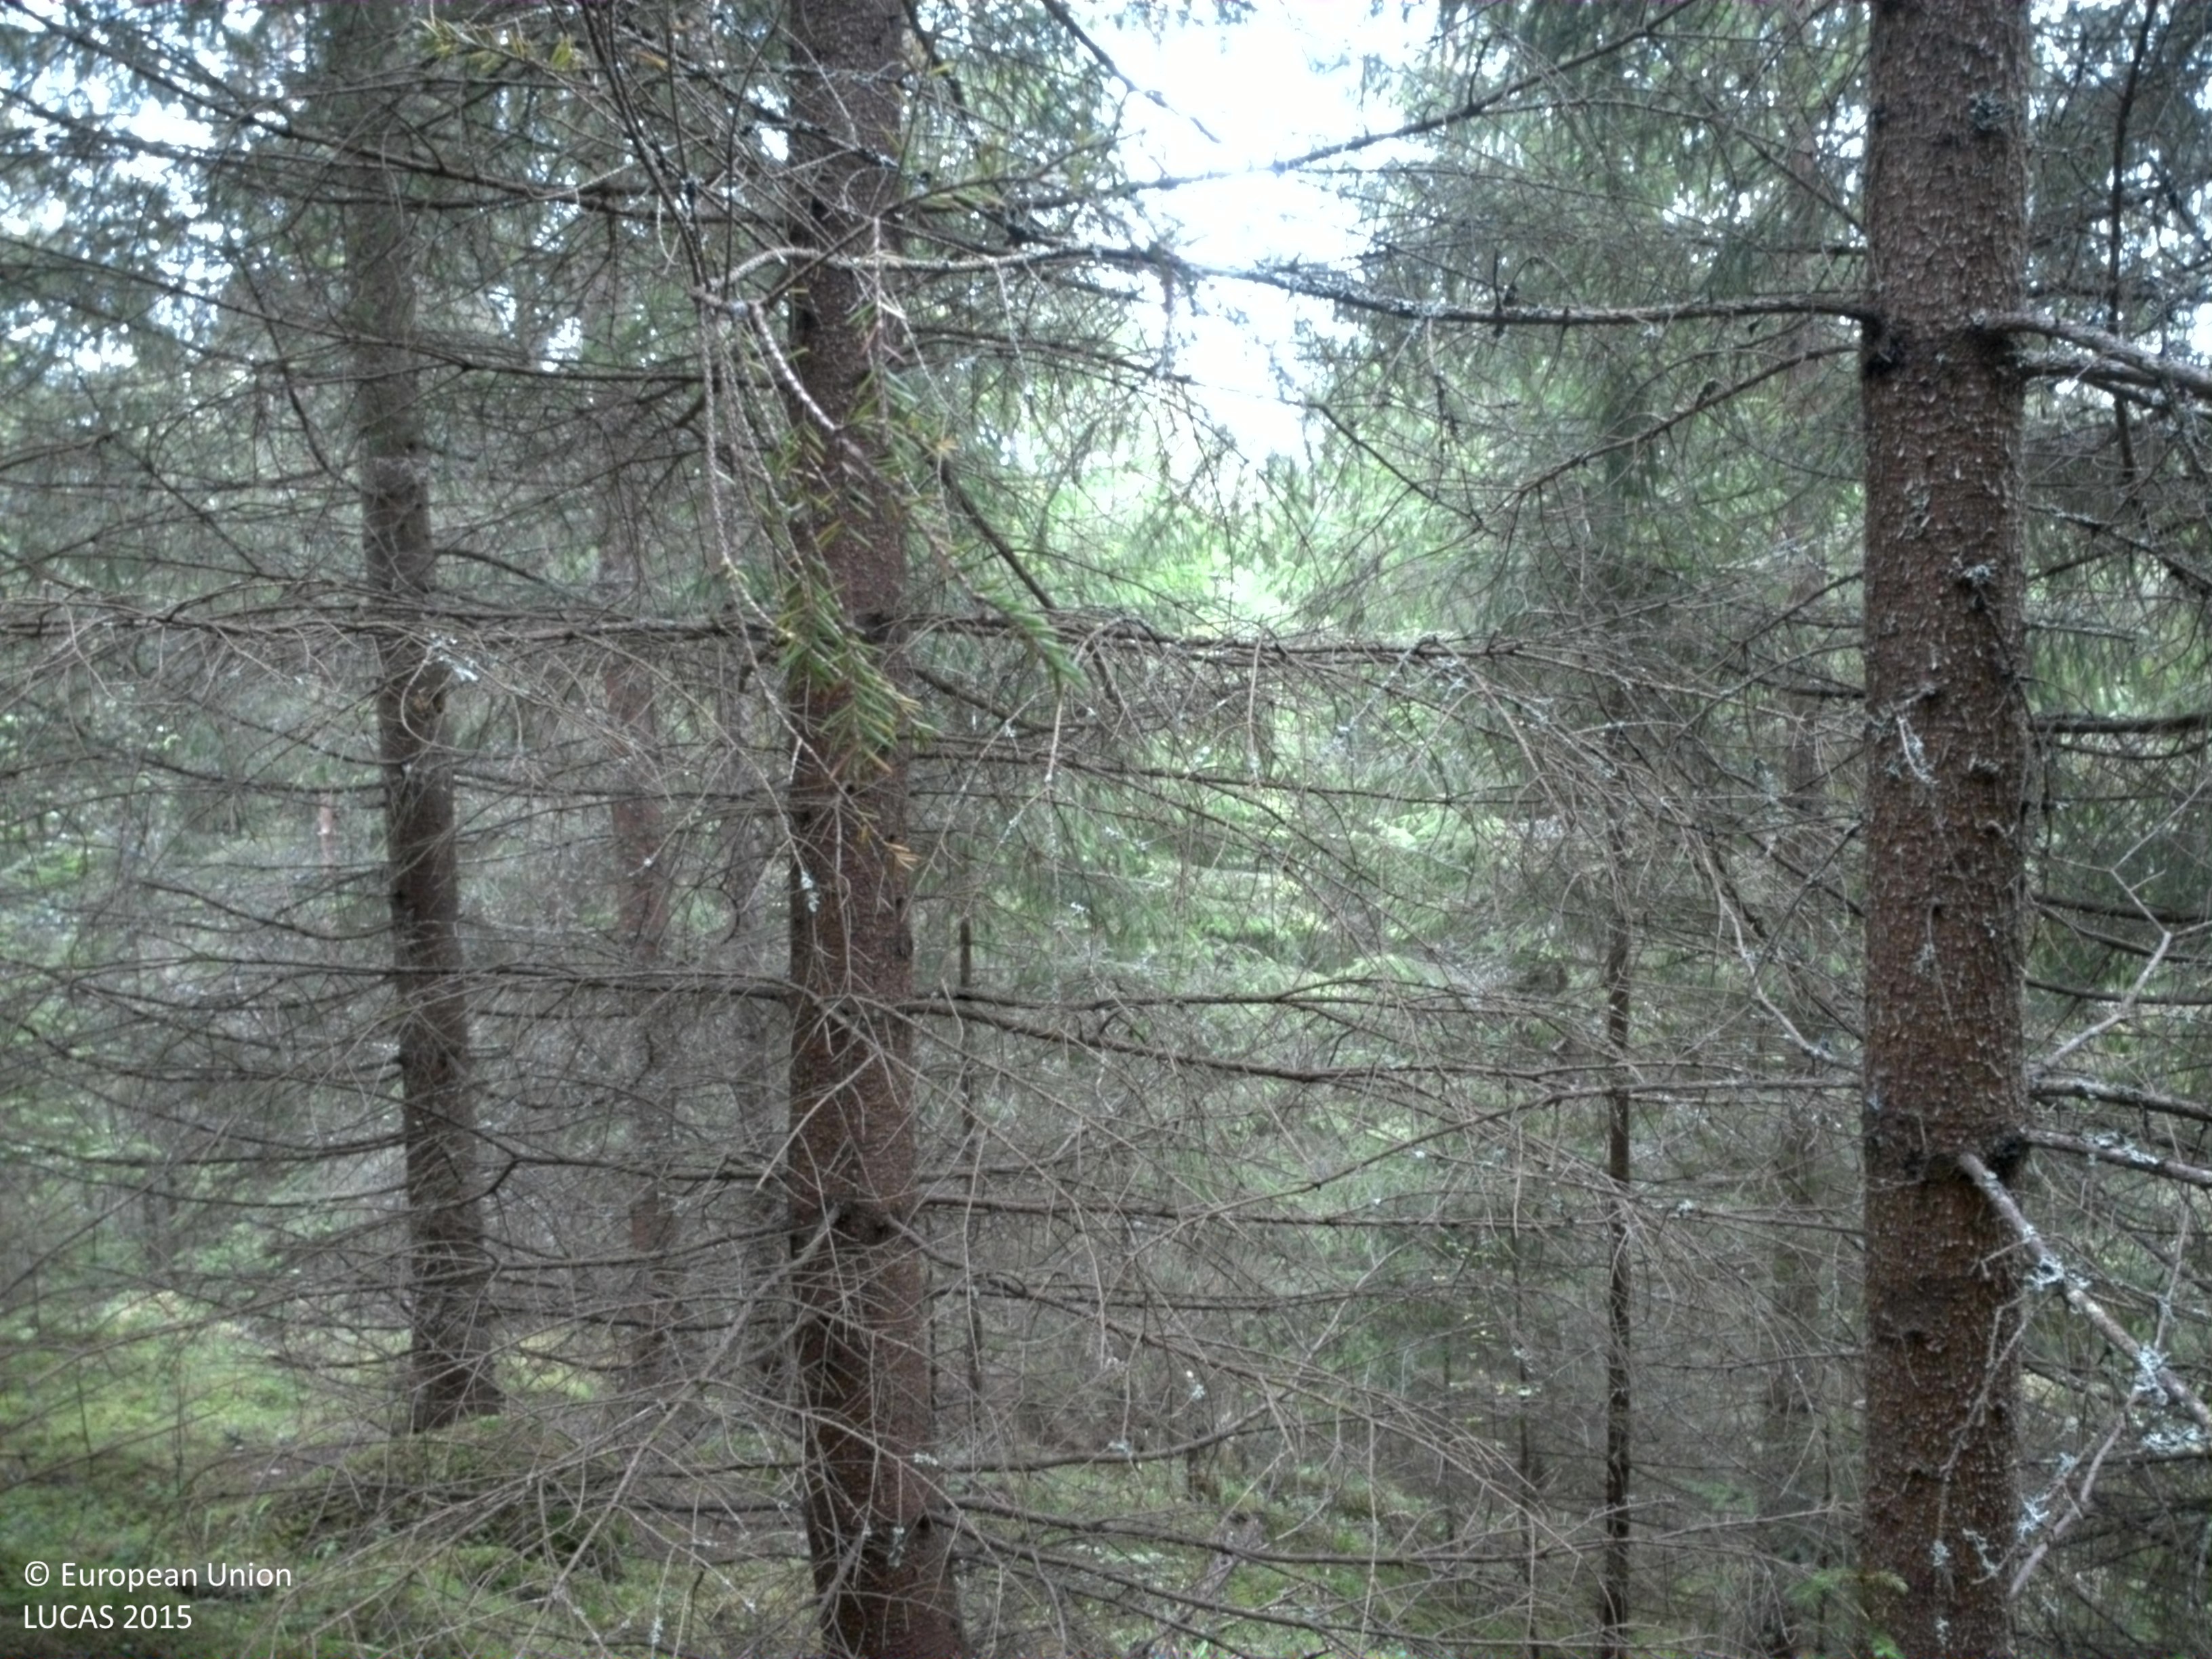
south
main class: Woodland
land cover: Spruce dominated coniferous woodland
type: boreal forest
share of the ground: 50 - 75 %
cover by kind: coniferous forest trees 70 %, lichens and mosses 25 %, shrubs 5 %
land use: Forestry
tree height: > 5 m
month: August
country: SE
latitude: 59.3565
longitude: 11.9826
